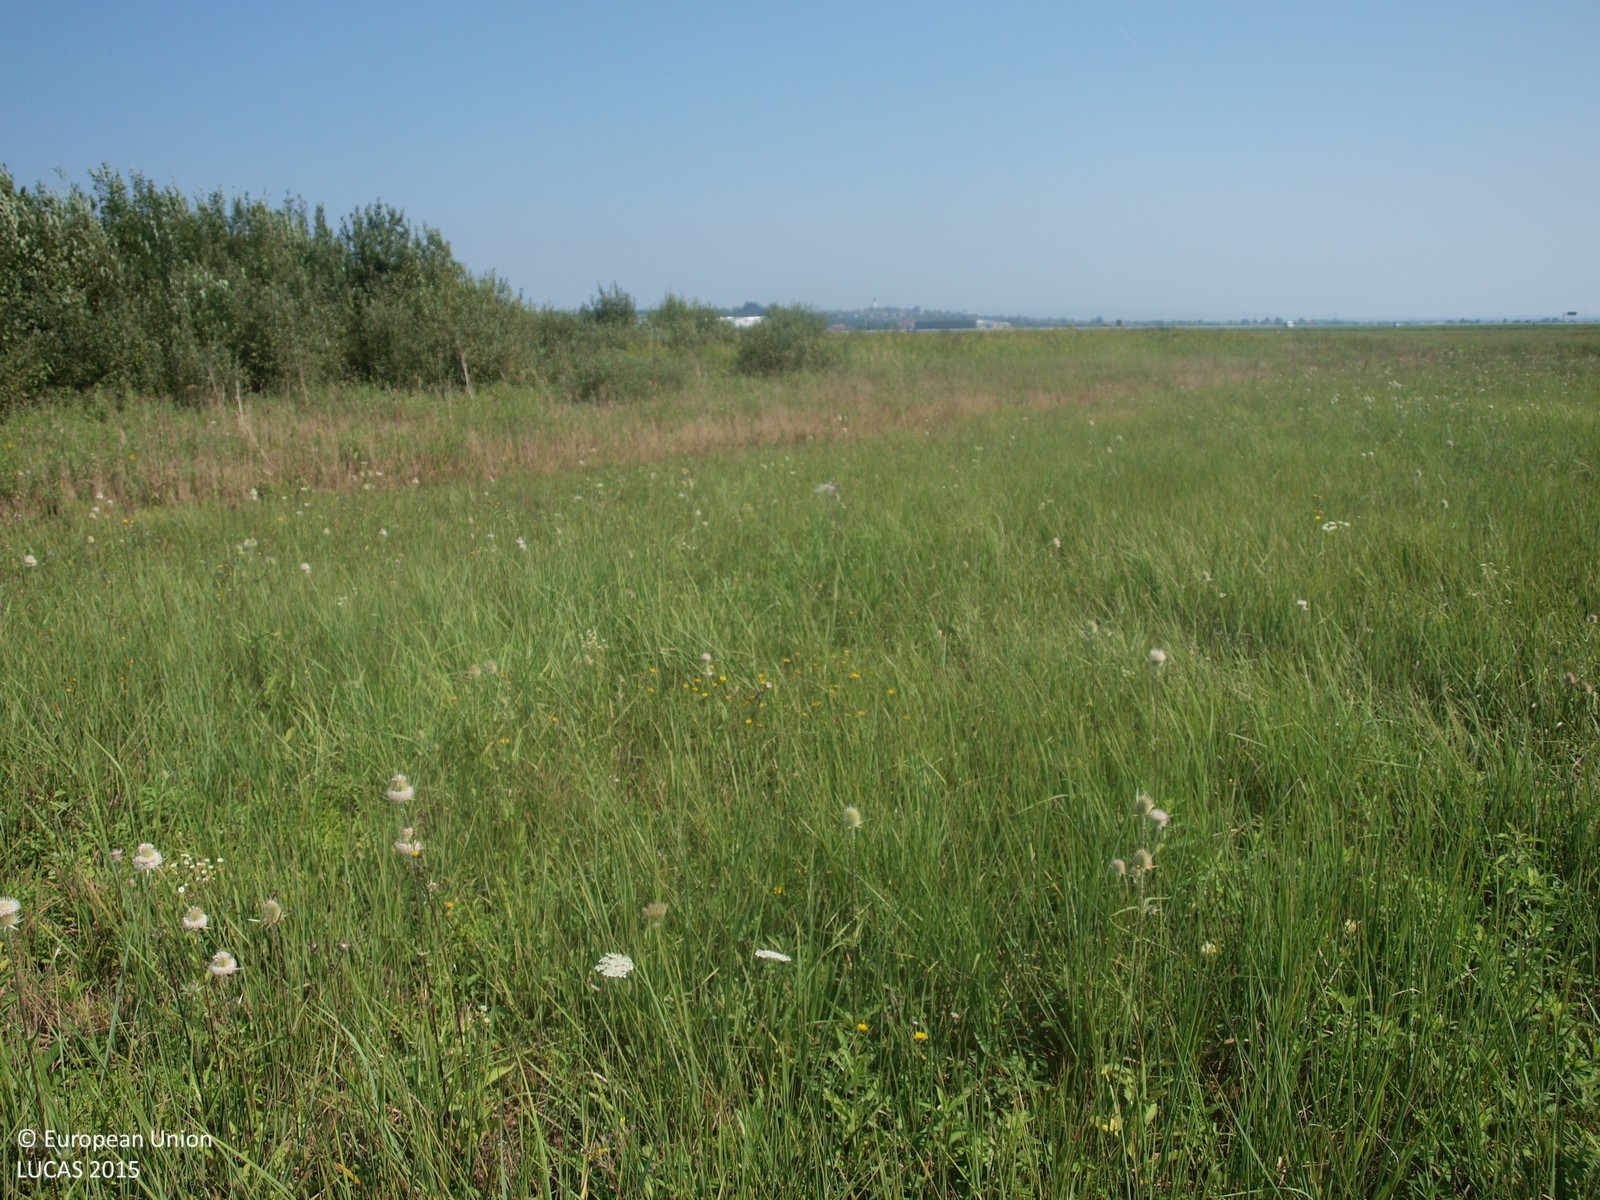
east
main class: Grassland
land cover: Grassland without tree/shrub cover
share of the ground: > 75 %
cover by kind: herbaceous plants 100 %
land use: Agriculture (excluding fallow land and kitchen gardens)
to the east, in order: Grassland without tree/shrub cover; Shrubland without tree cover; Ditches and canals; Grassland without tree/shrub cover
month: August
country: HR
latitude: 45.6667
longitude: 16.4806
